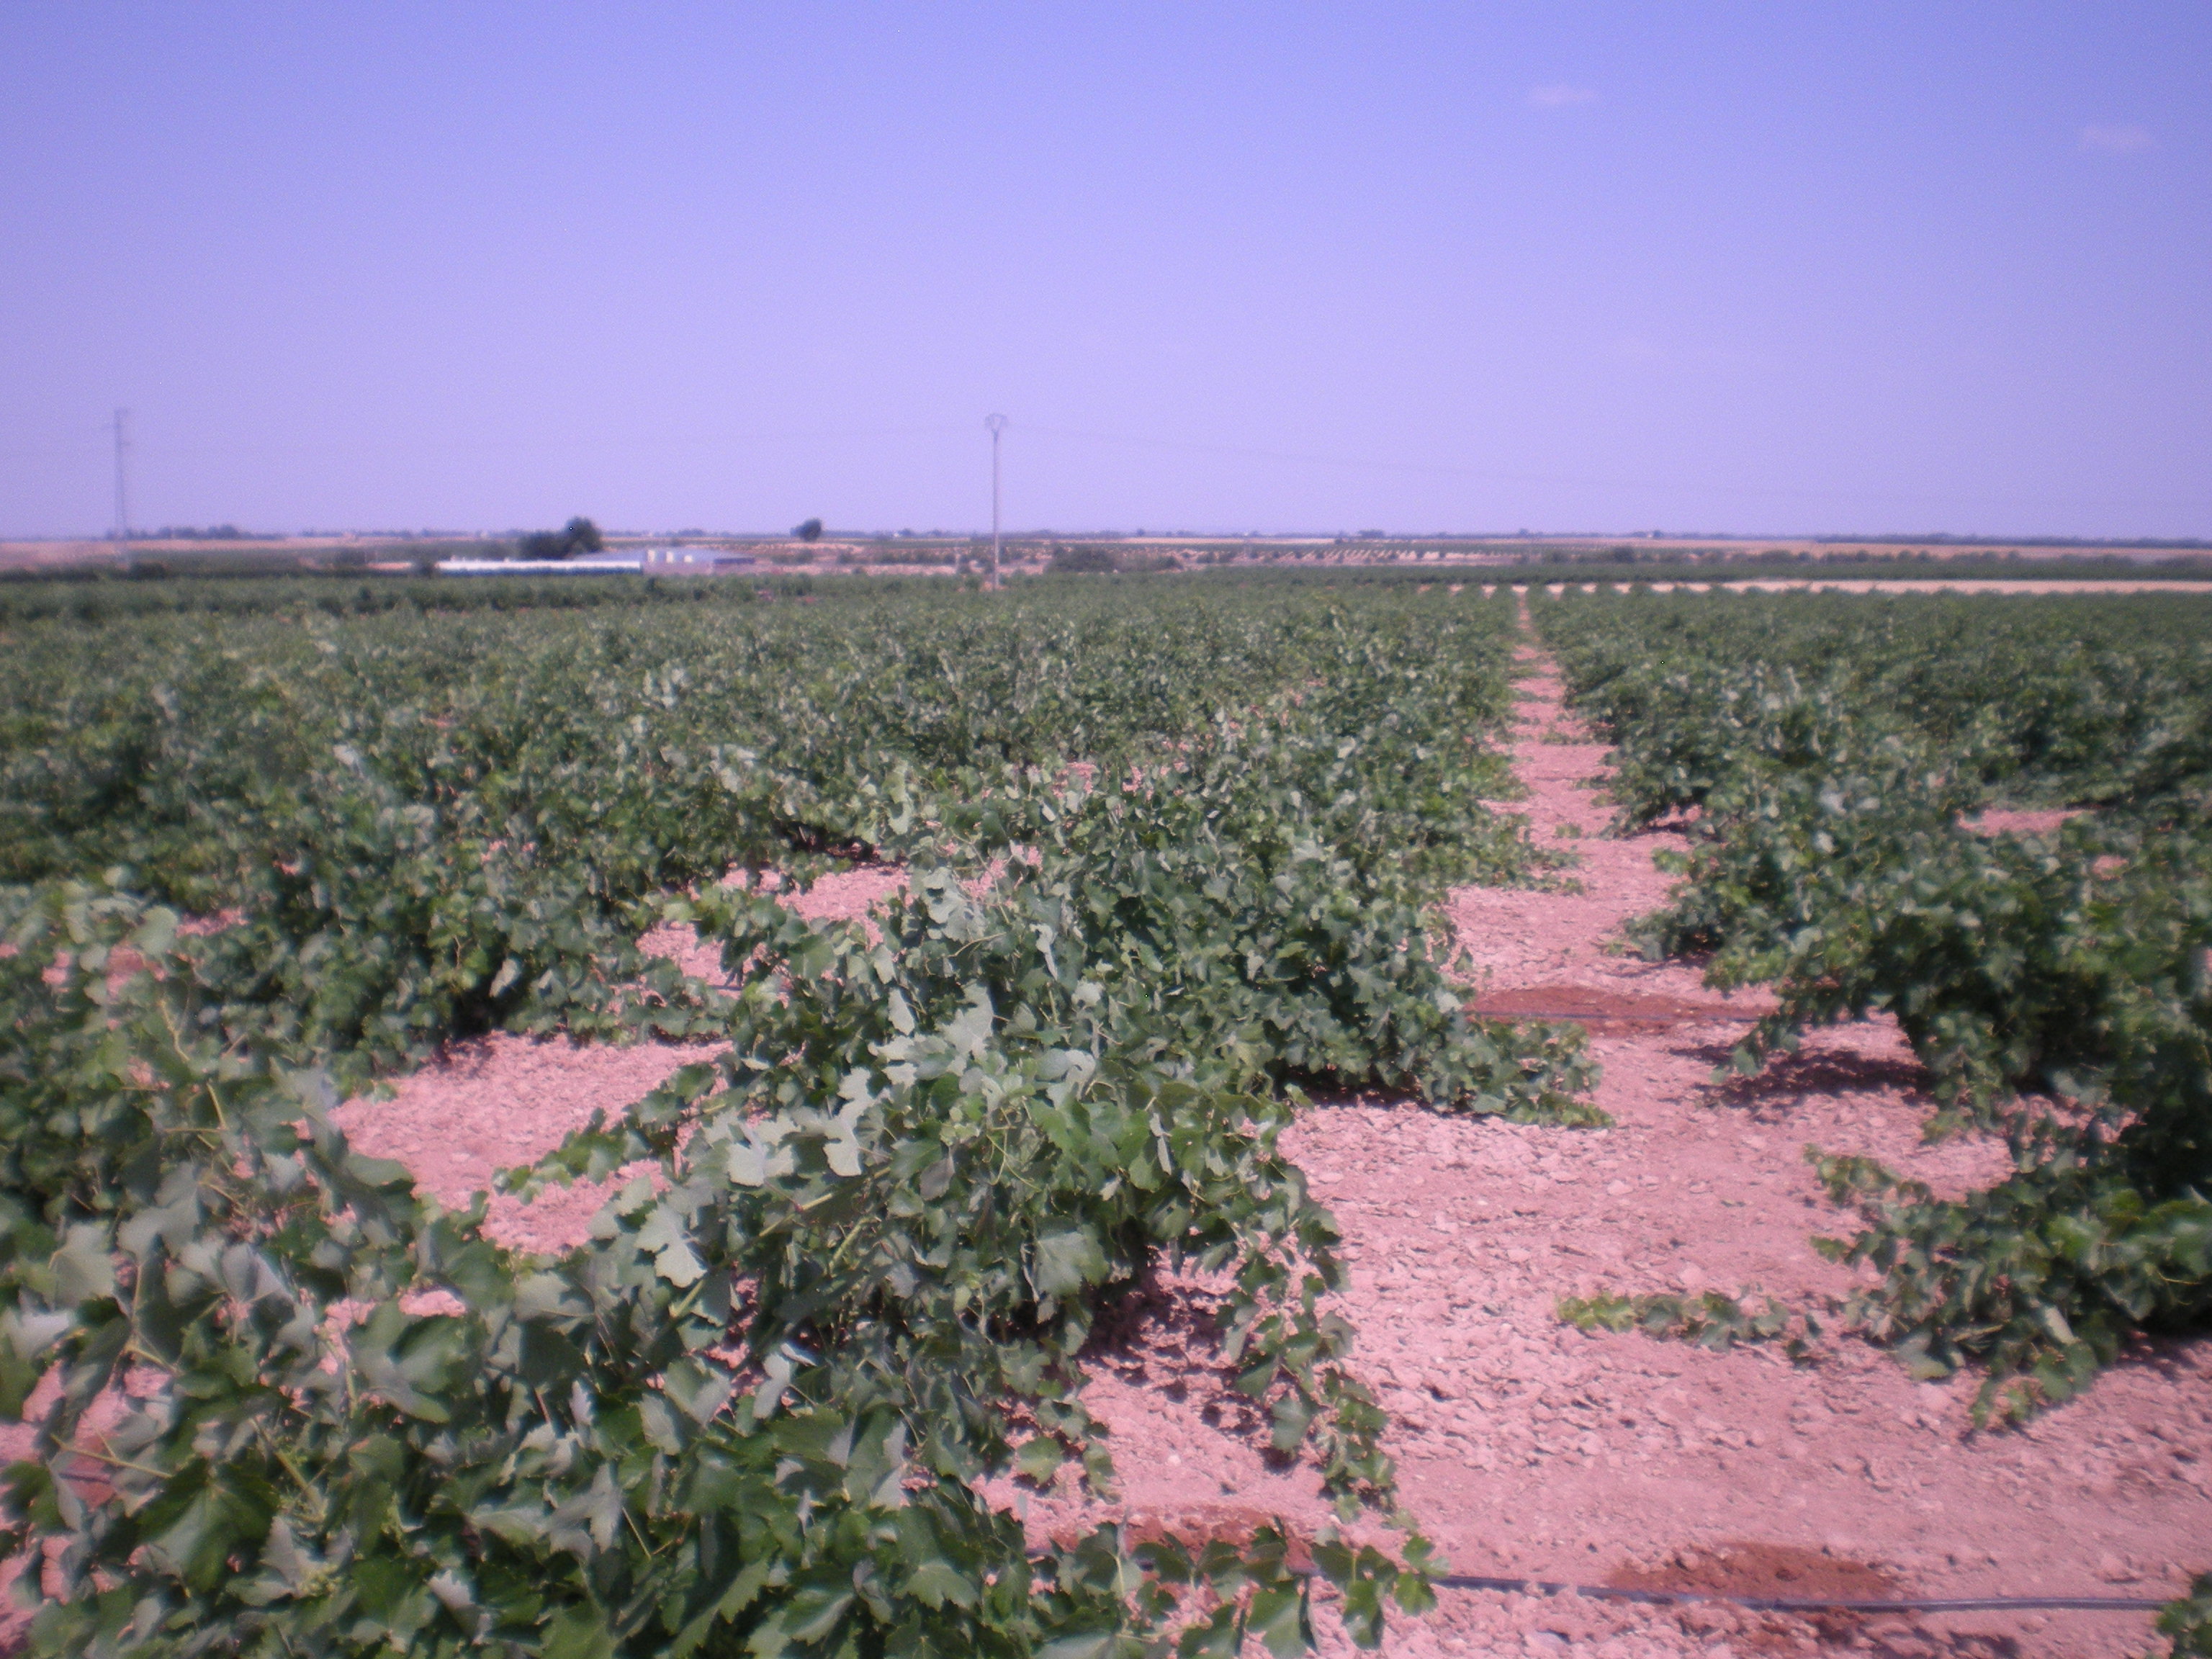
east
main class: Cropland
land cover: Vineyards
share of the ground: 25 - 50 %
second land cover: Other bare soil
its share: > 75 %
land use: Agriculture (excluding fallow land and kitchen gardens)
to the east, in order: Vineyards; Other bare soil; Electric lines; Grass margins; Tracks; Grass margins; Vineyards
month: June
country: ES
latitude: 39.6090
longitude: -3.3349
